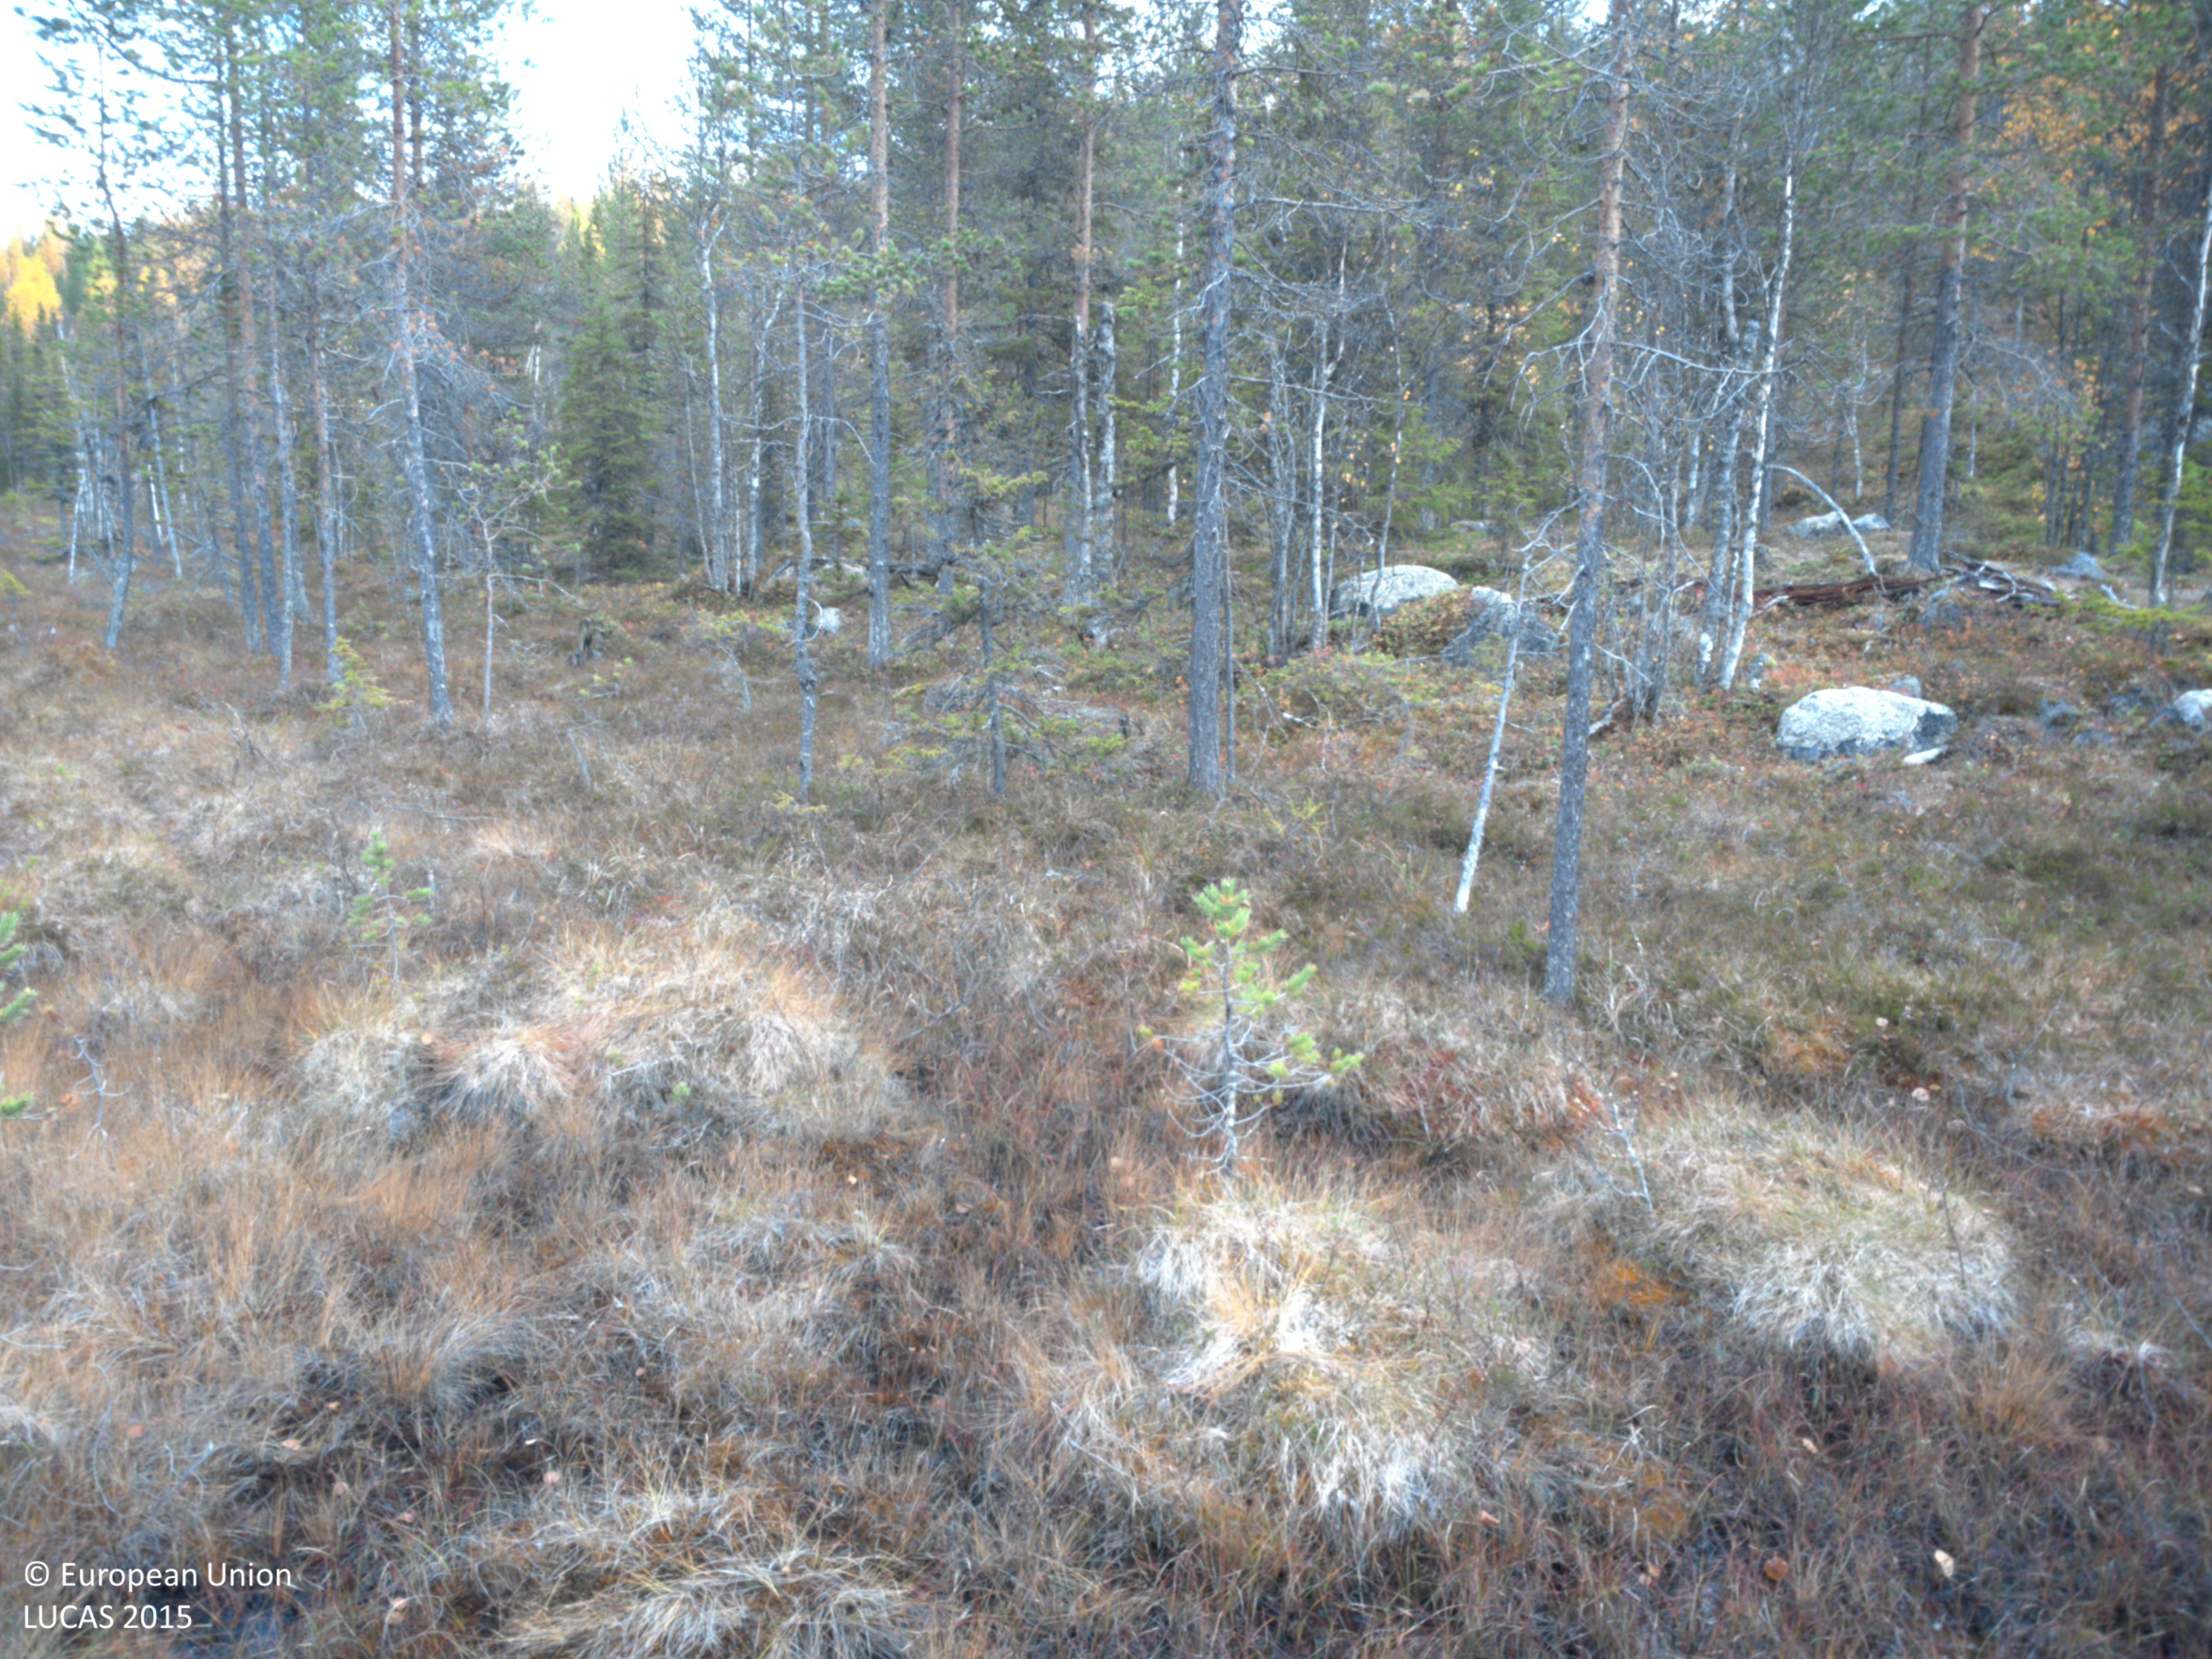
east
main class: Woodland
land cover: Pine dominated coniferous woodland
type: mire and swamp forests
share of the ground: 10 - 25 %
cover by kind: coniferous forest trees 30 %, shrubs 30 %, herbaceous plants 30 %, lichens and mosses 10 %
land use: Semi-natural and natural areas not in use
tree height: < 5 m
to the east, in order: Pine dominated coniferous woodland; Spruce dominated mixed woodland; Pine dominated coniferous woodland; Spruce dominated mixed woodland; Pine dominated mixed woodland
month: September
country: SE
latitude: 65.0015
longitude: 18.5961
